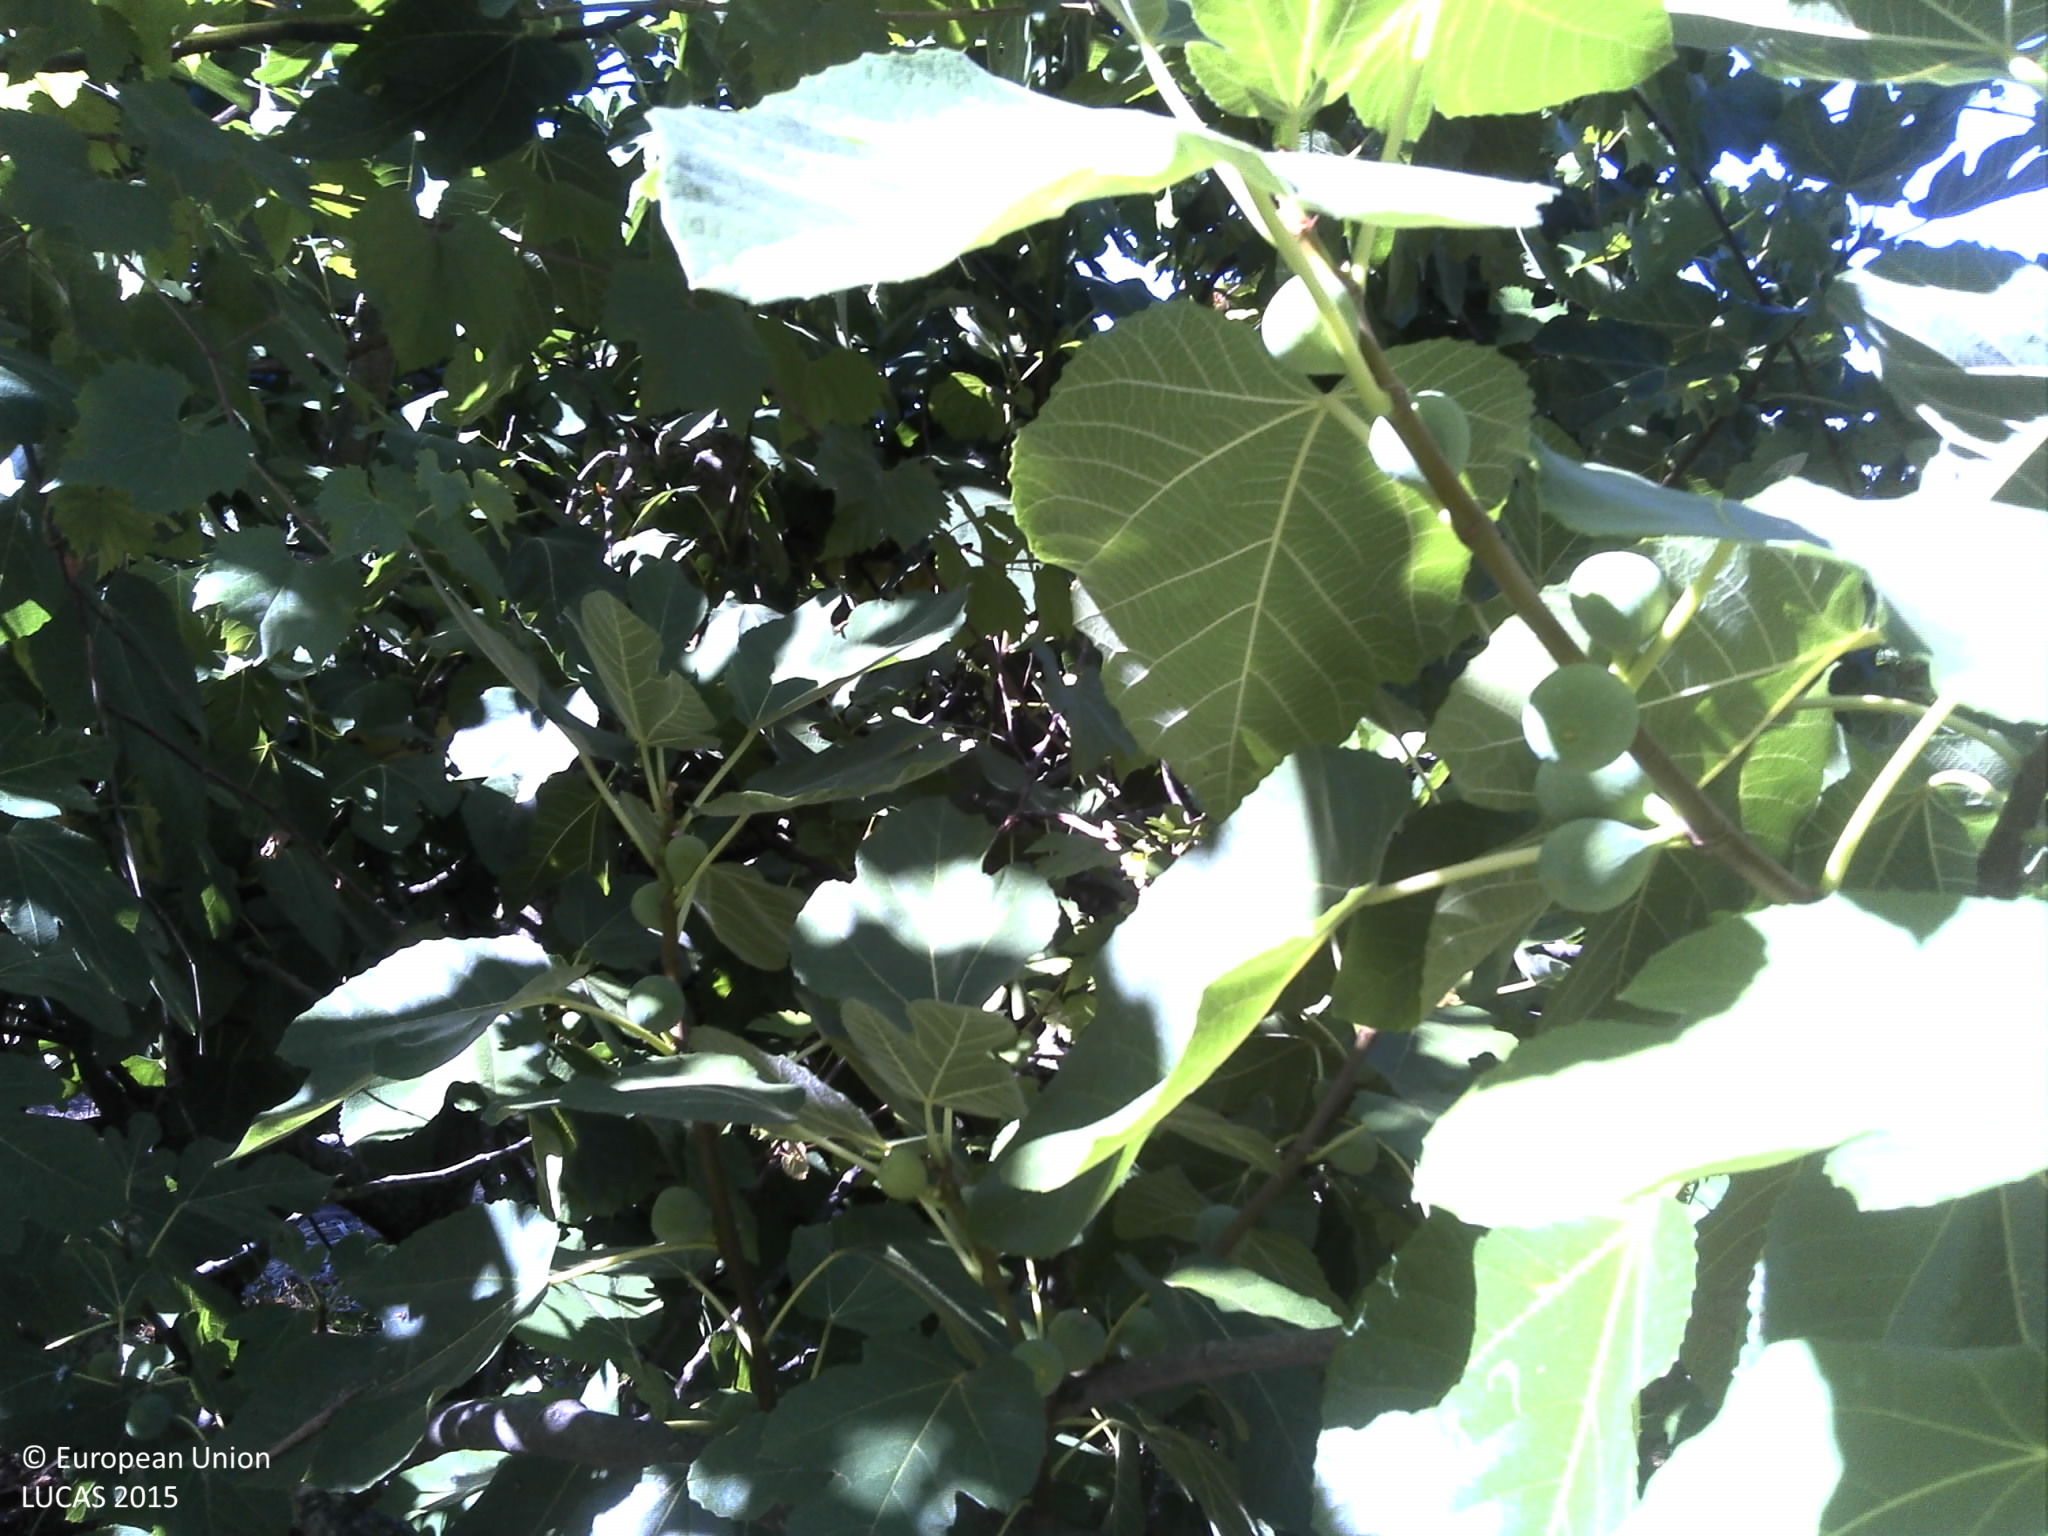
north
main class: Cropland
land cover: Olive groves
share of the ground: < 10 %
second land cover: Grassland without tree/shrub cover
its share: > 75 %
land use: Agriculture (excluding fallow land and kitchen gardens)
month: July
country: PT
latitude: 41.3038
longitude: -7.3794
